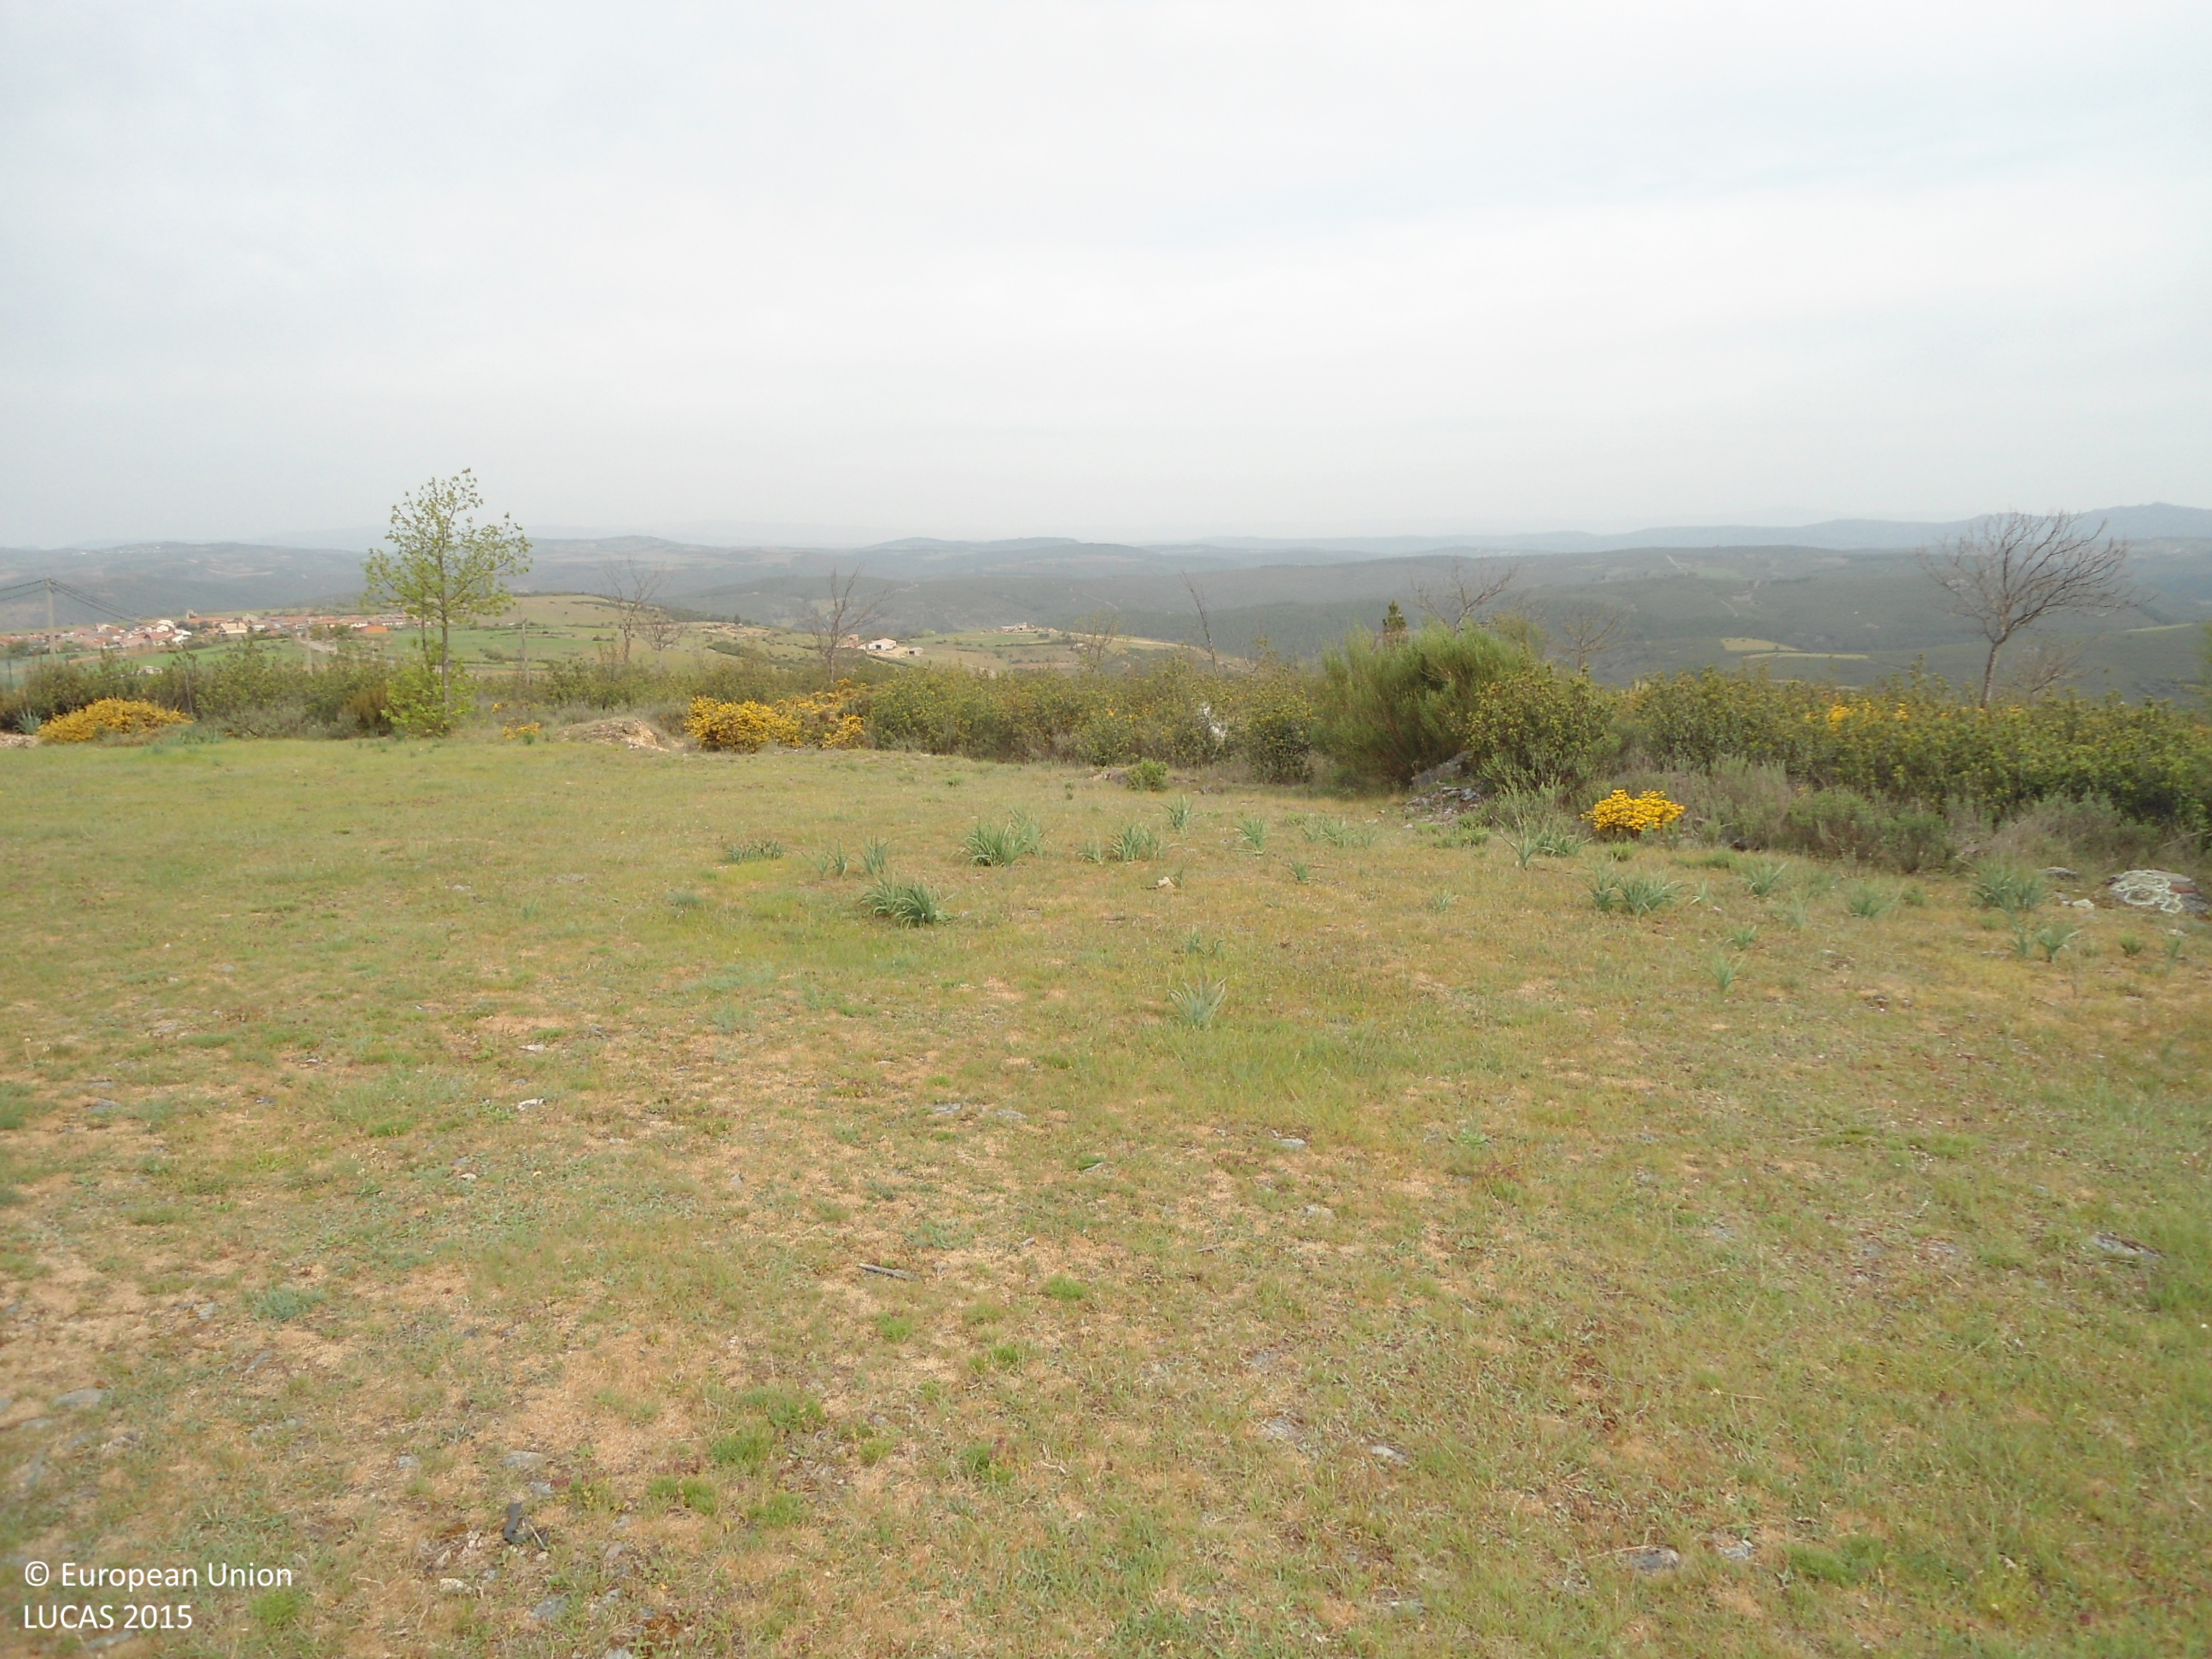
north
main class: Grassland
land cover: Grassland without tree/shrub cover
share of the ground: > 75 %
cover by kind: herbaceous plants 100 %
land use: Community services
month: April
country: ES
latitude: 41.7677
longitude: -6.5024
